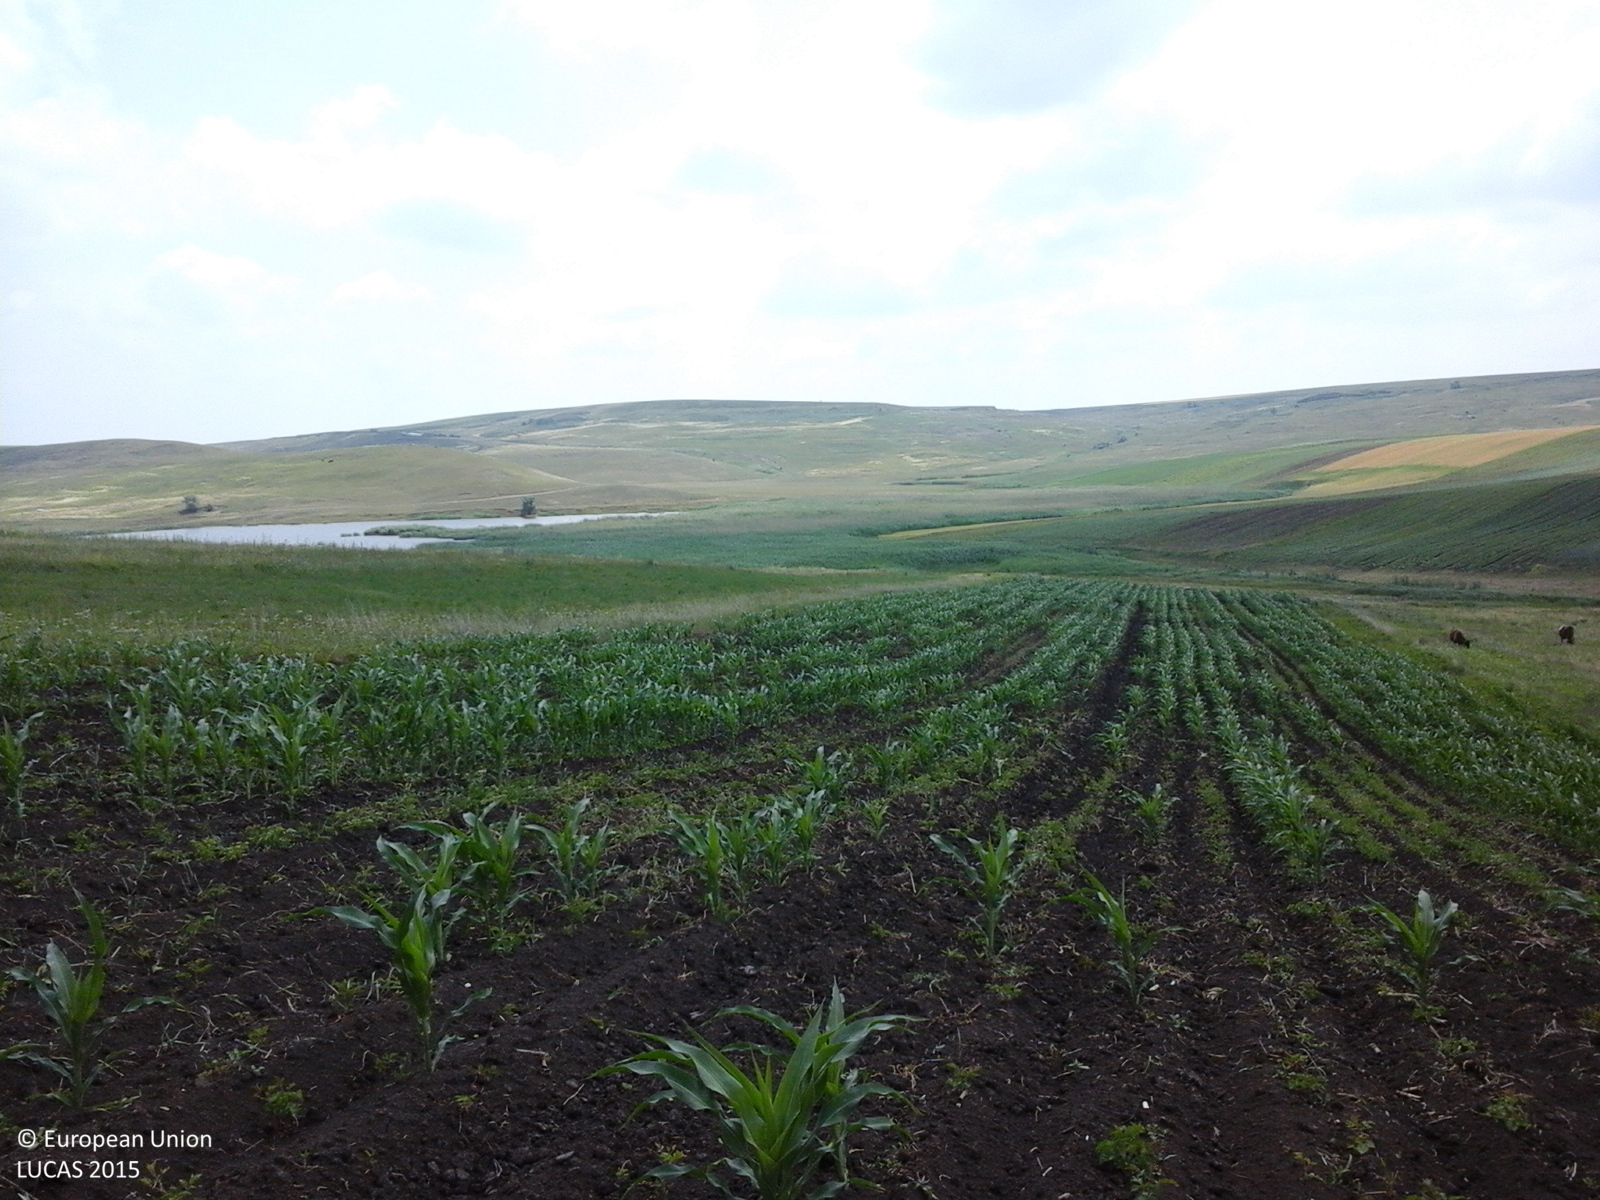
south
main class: Cropland
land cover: Maize
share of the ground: 25 - 50 %
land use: Agriculture (excluding fallow land and kitchen gardens)
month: June
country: RO
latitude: 48.0496
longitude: 26.6374
